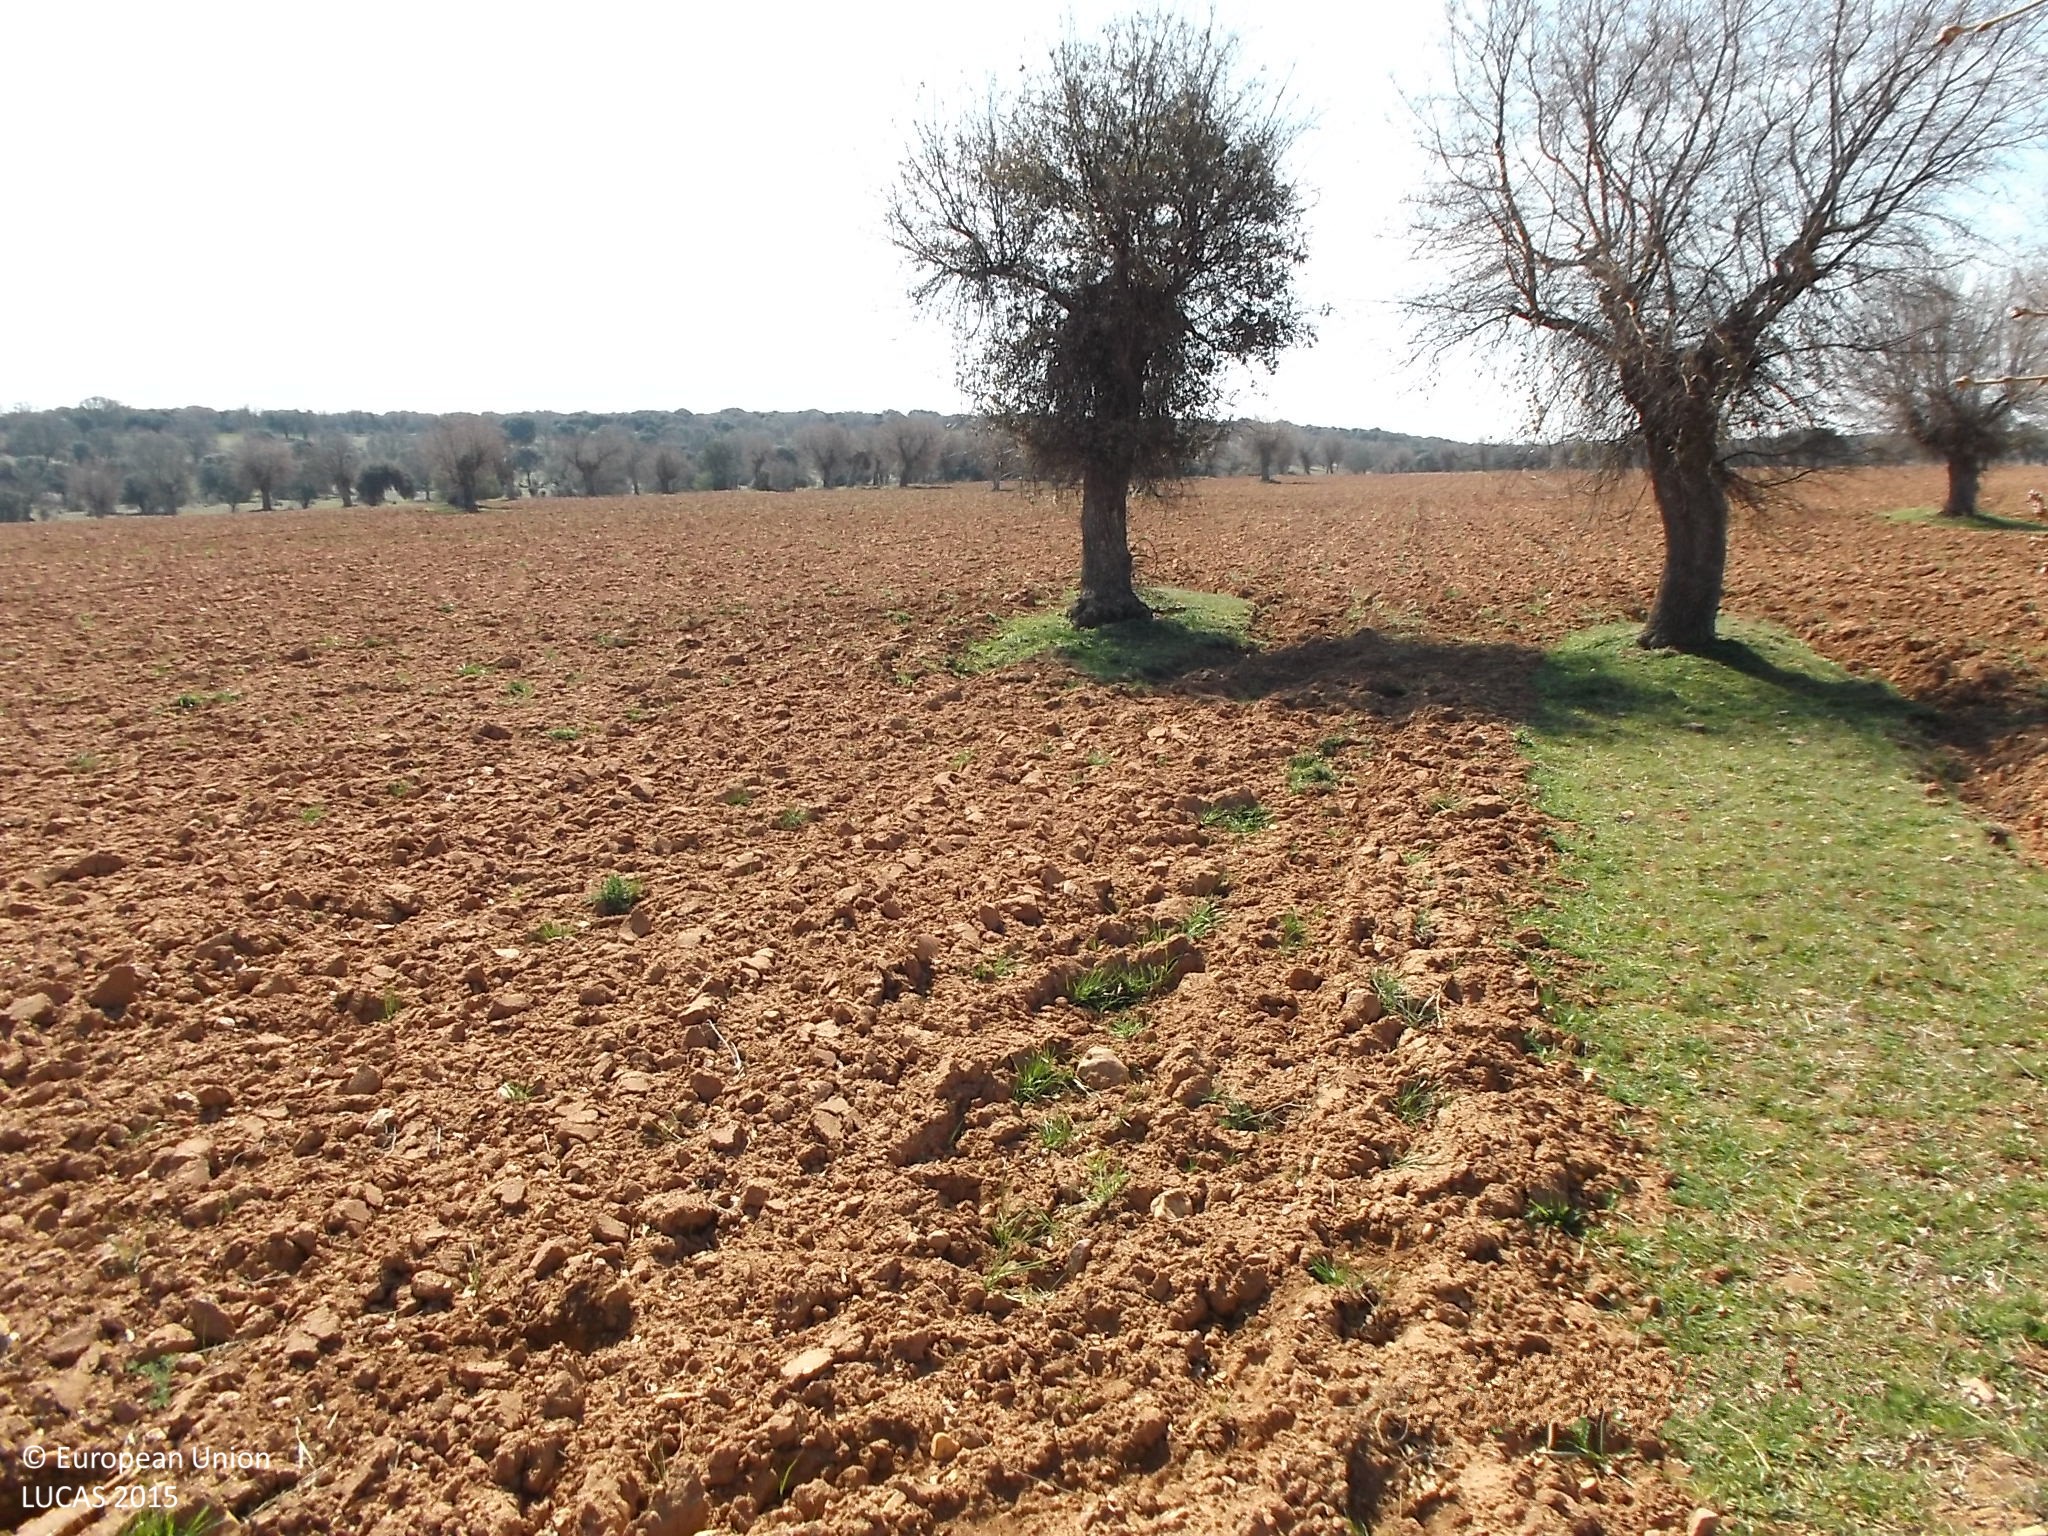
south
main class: Woodland
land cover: Broadleaved woodland
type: broadleaved evergreen forest
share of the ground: 10 - 25 %
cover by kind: unconsolidated bare surface 85 %, broadleaved forest trees 15 %
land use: Forestry
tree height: < 5 m
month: April
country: ES
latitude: 40.8568
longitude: -5.8934
